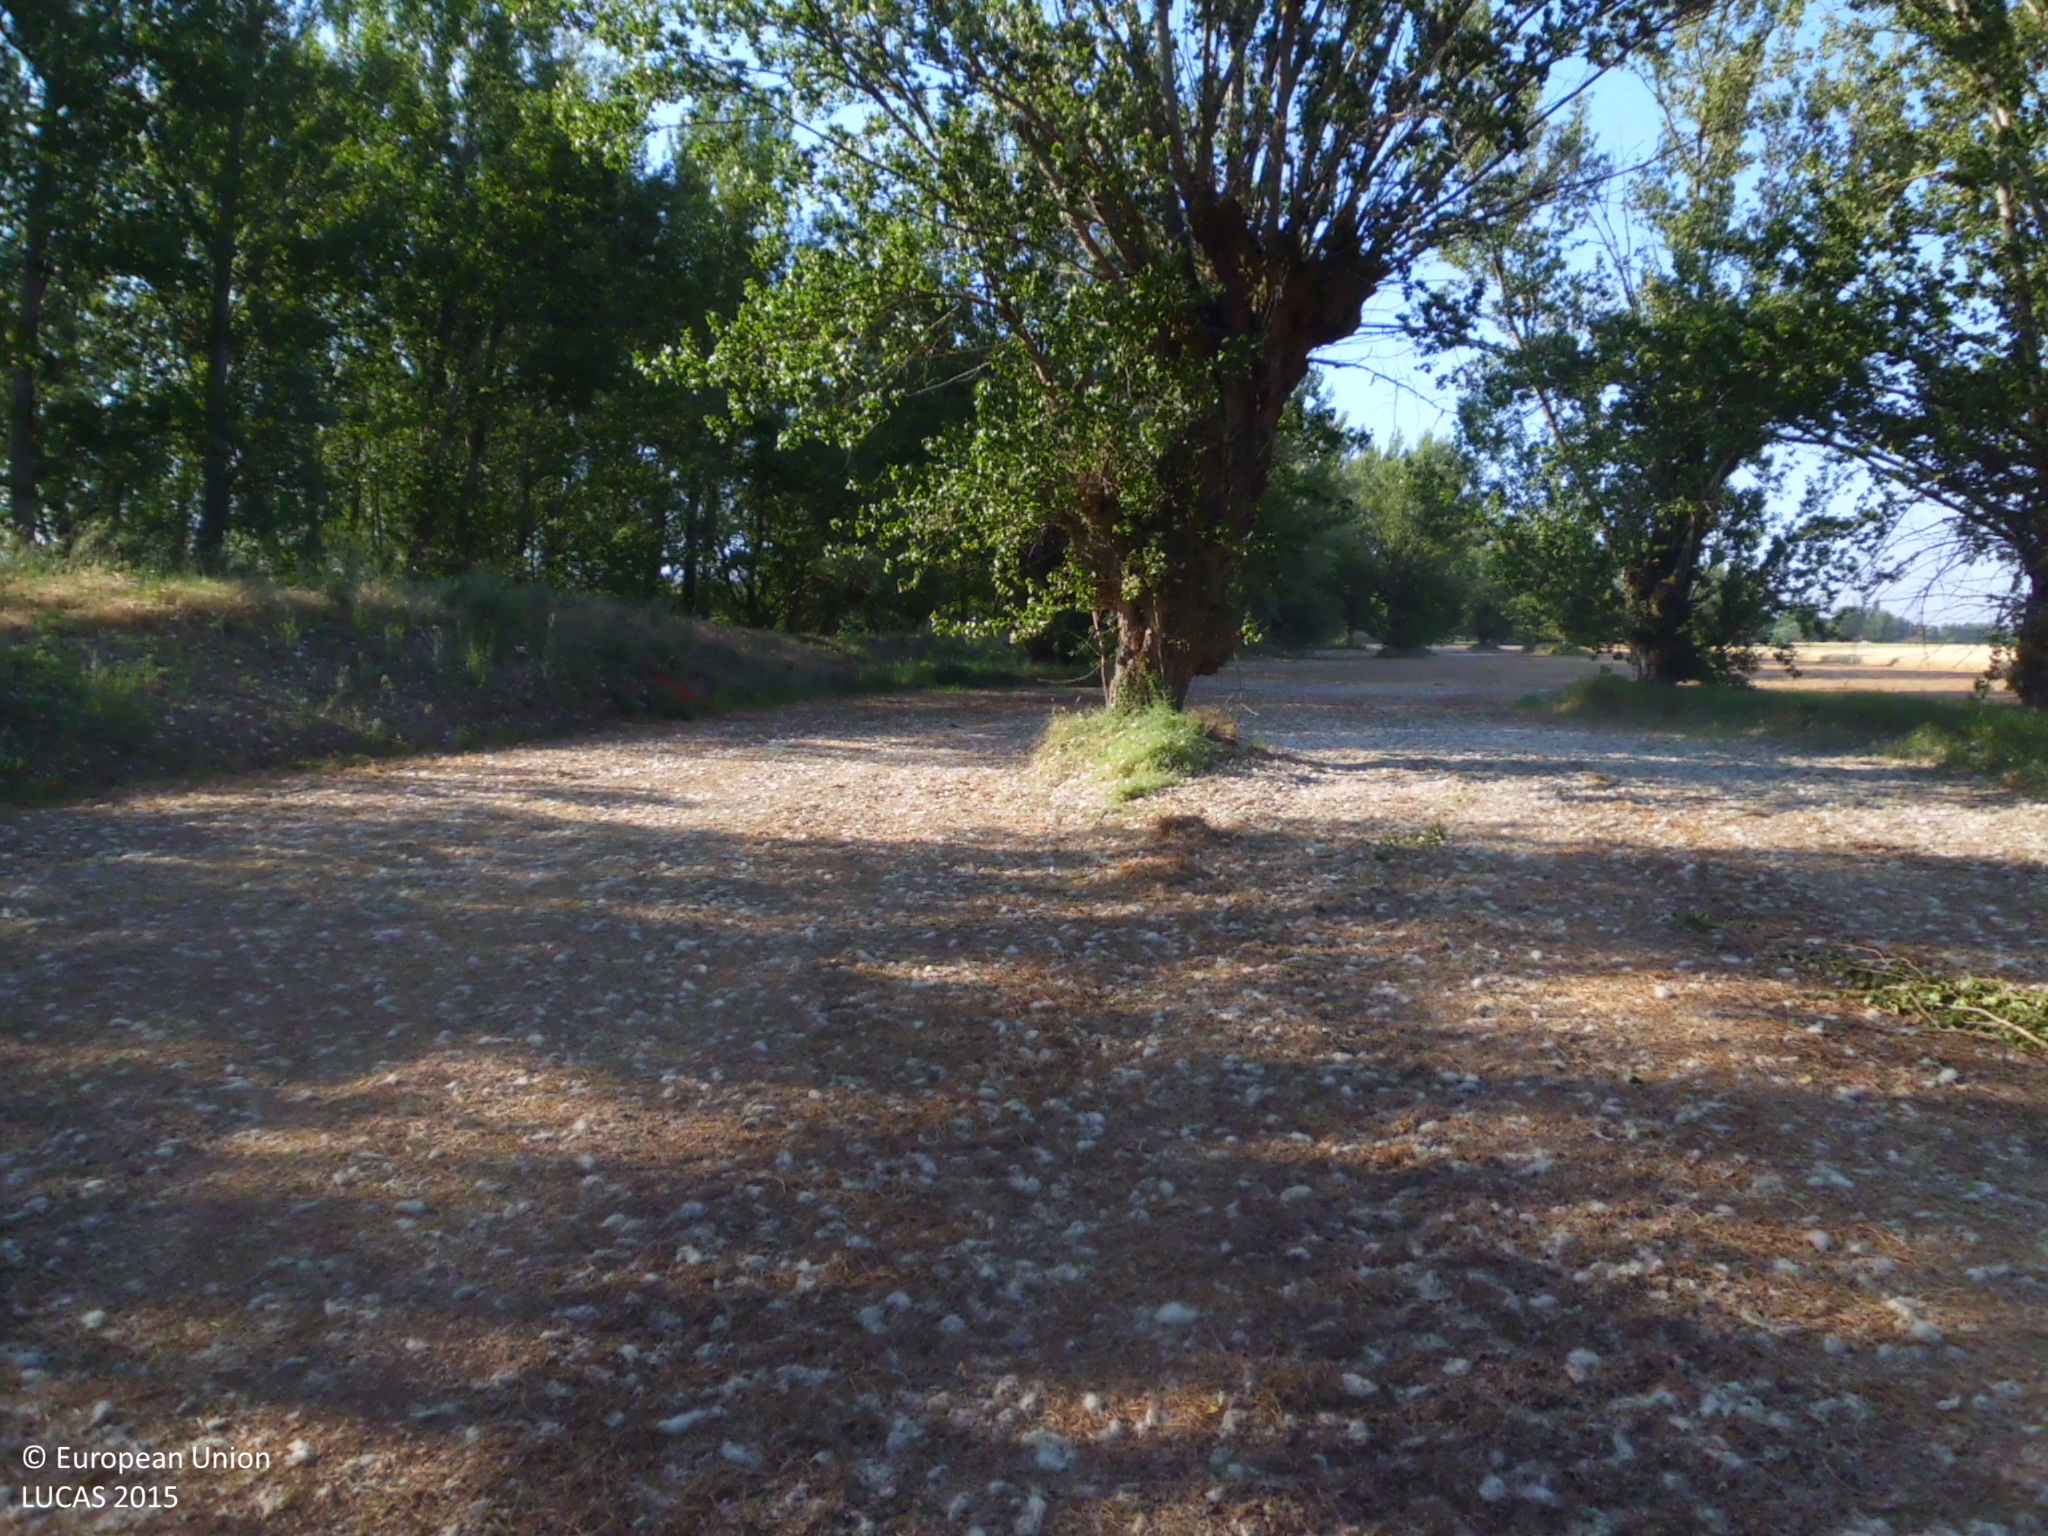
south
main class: Cropland
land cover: Mixed cereals for fodder
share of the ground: 50 - 75 %
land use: Agriculture (excluding fallow land and kitchen gardens)
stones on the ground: < 10 %
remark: Harvested field
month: June
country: ES
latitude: 42.4787
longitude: -4.0196
